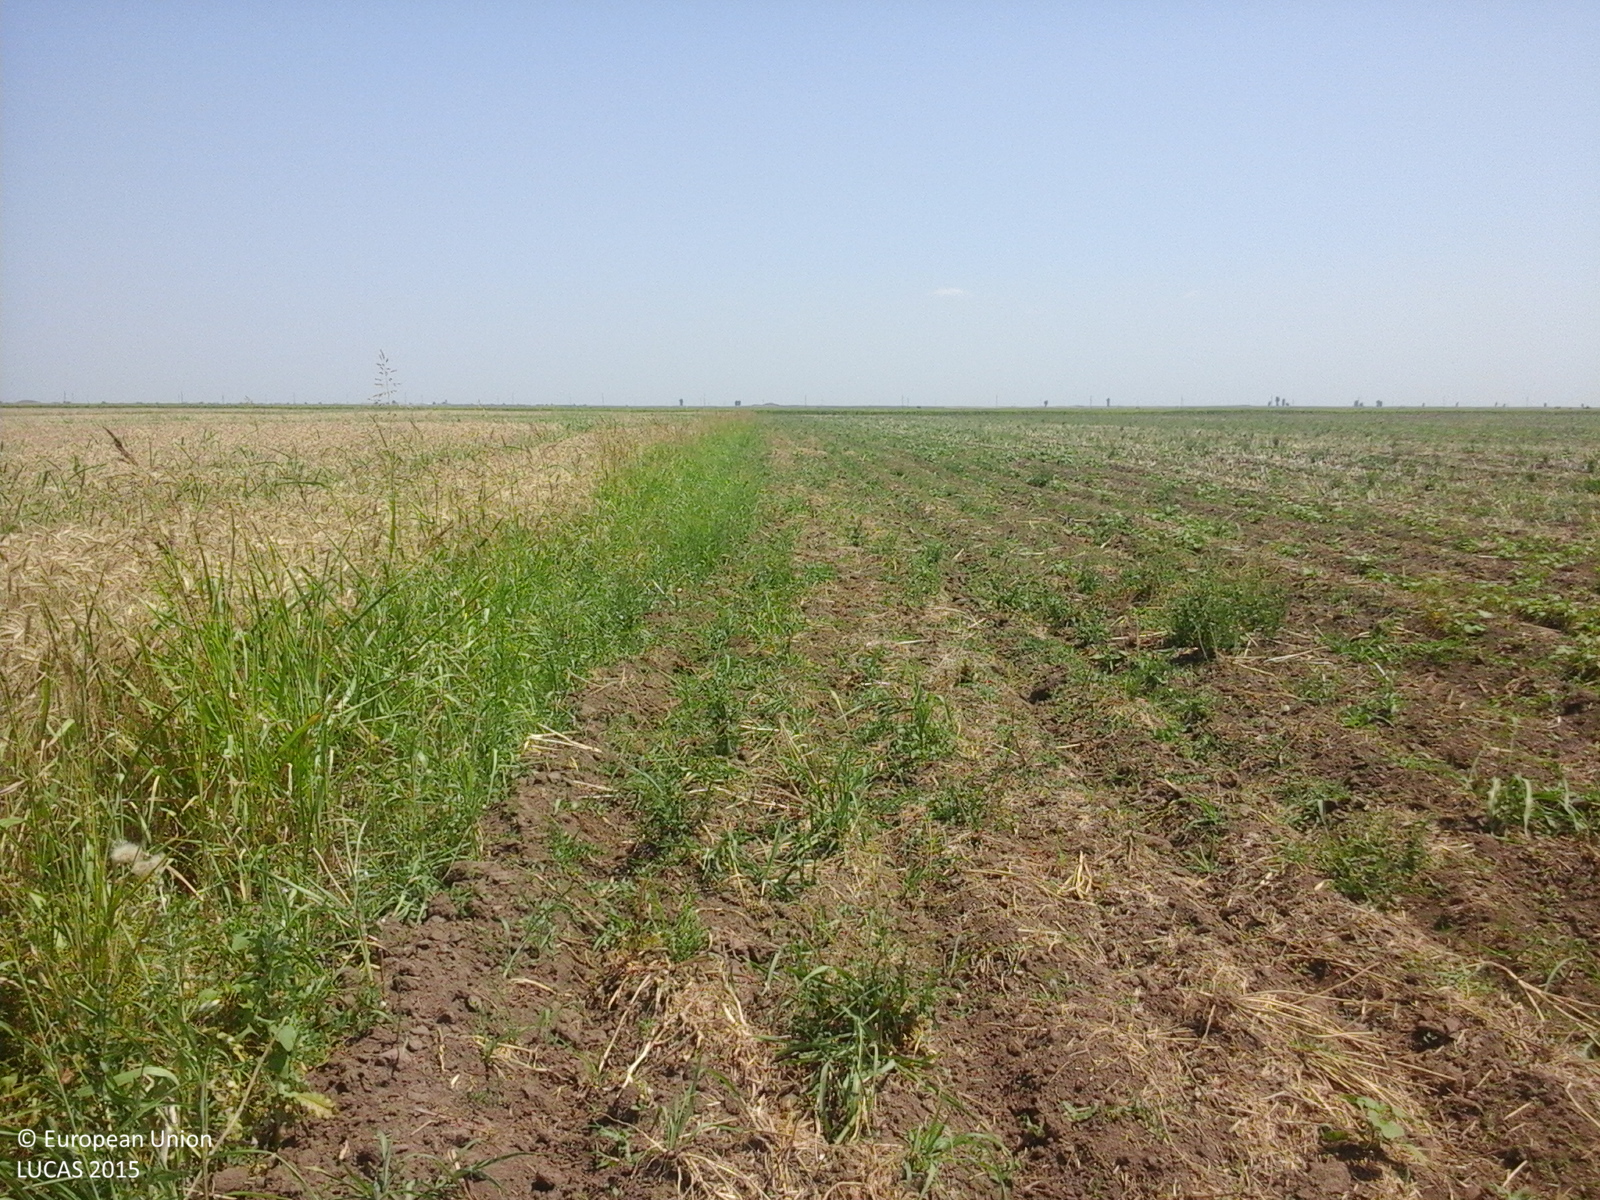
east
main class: Cropland
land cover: Common wheat
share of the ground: > 75 %
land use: Agriculture (excluding fallow land and kitchen gardens)
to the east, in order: Common wheat
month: July
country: RO
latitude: 44.7367
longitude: 27.6657
